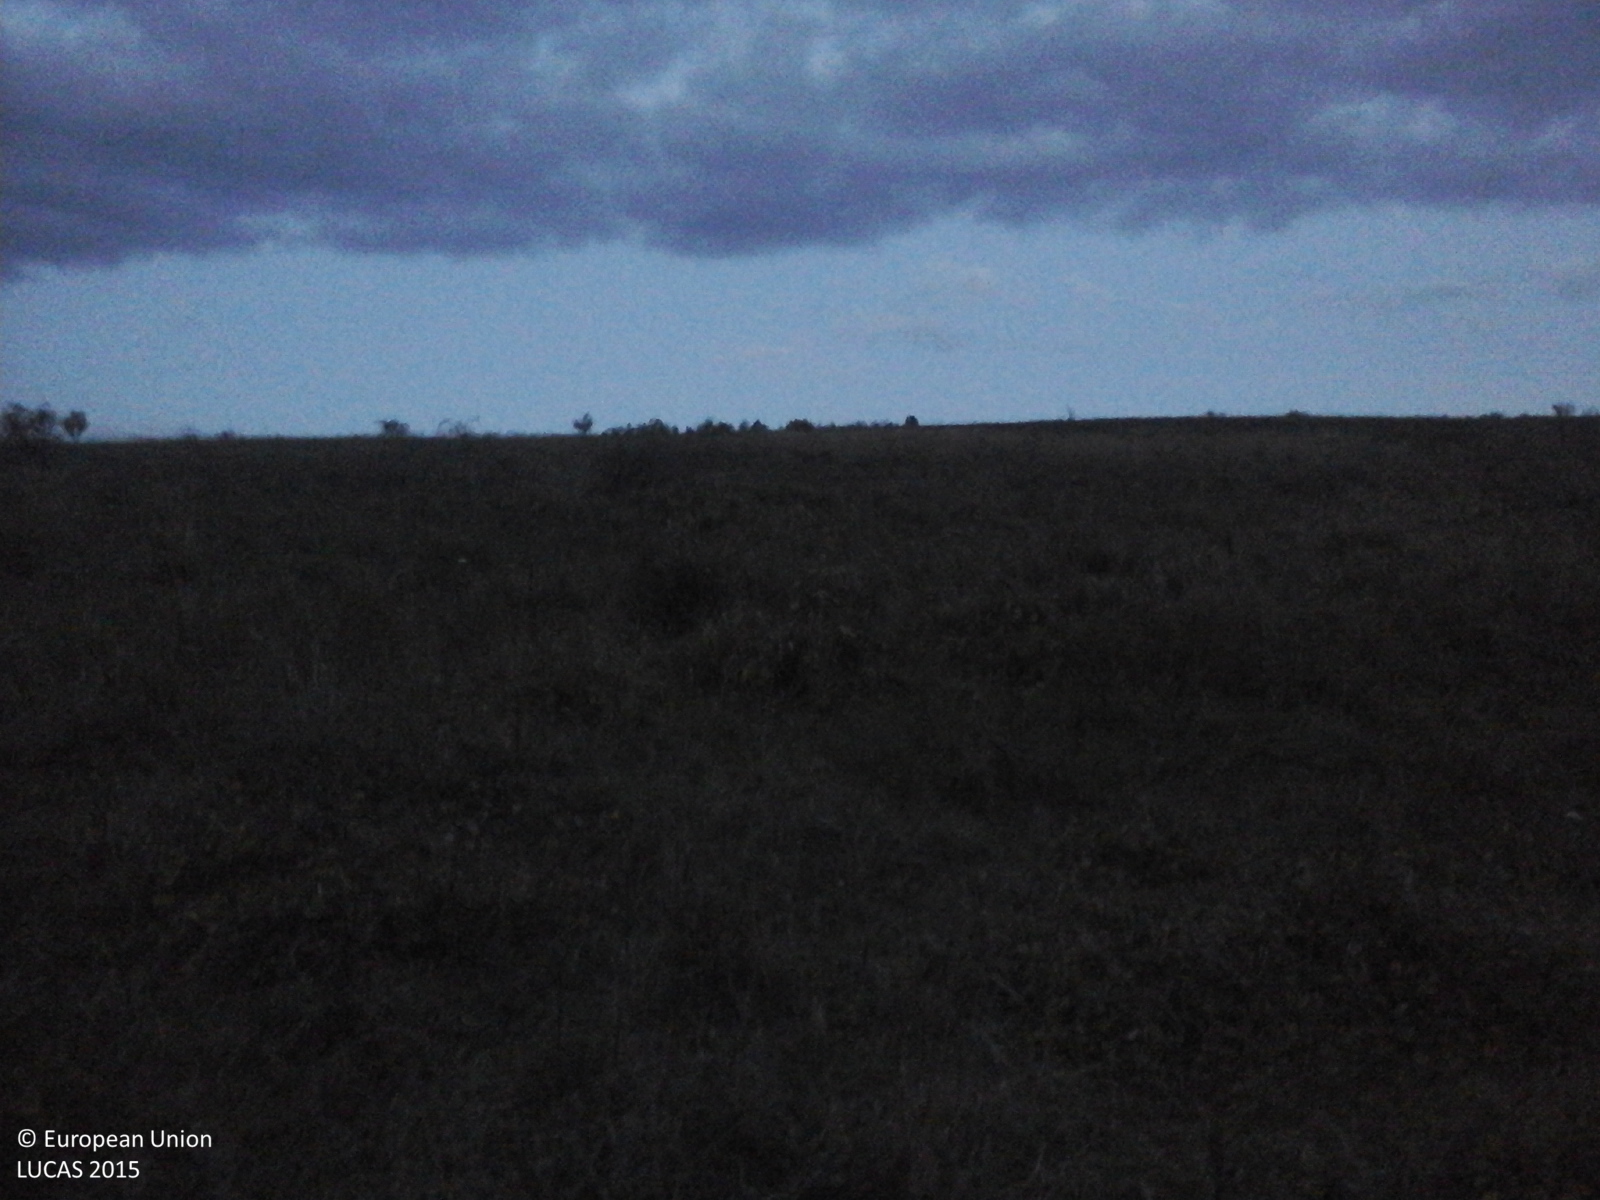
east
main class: Grassland
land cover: Spontaneously vegetated surfaces
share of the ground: > 75 %
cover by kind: herbaceous plants 100 %
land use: Agriculture (excluding fallow land and kitchen gardens)
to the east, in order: Spontaneously vegetated surfaces; Tracks; Spontaneously vegetated surfaces
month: October
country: RO
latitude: 45.0603
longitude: 26.2558
